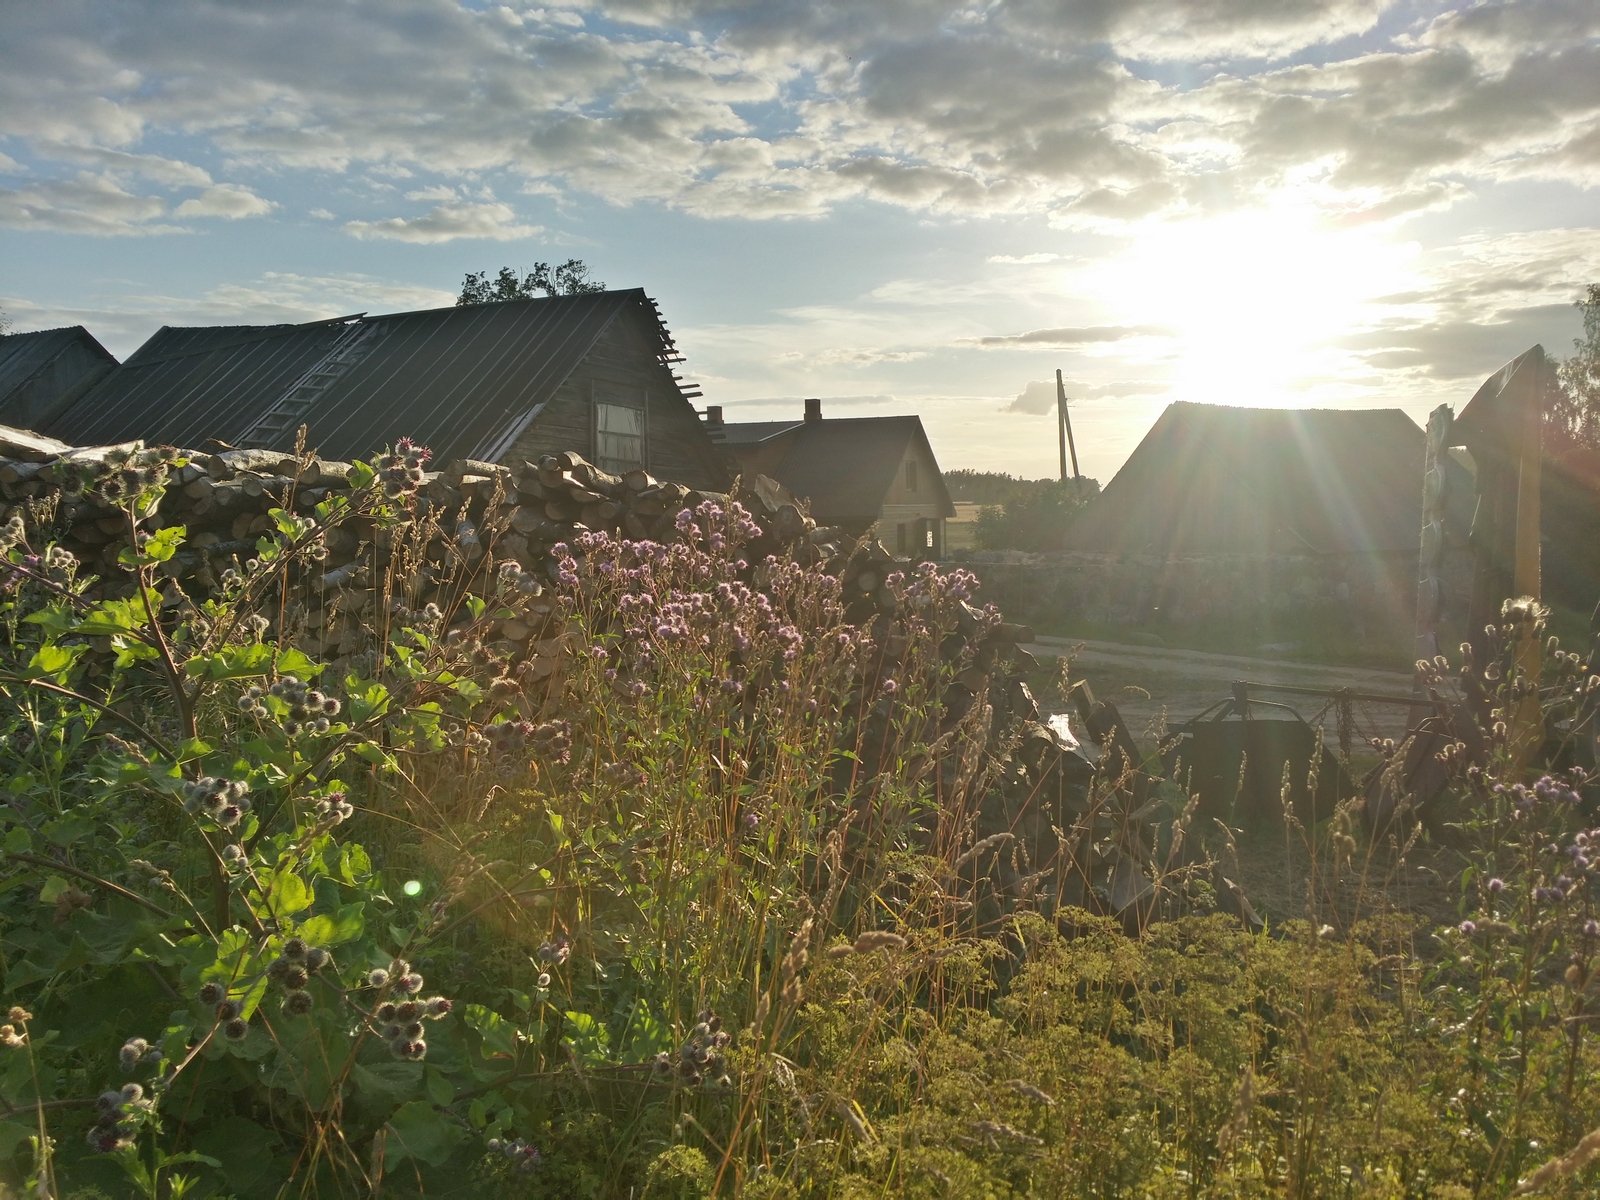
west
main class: Grassland
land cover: Spontaneously vegetated surfaces
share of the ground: > 75 %
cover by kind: herbaceous plants 95 %, shrubs 5 %
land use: Semi-natural and natural areas not in use
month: July
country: LV
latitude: 57.2970
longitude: 26.6607
